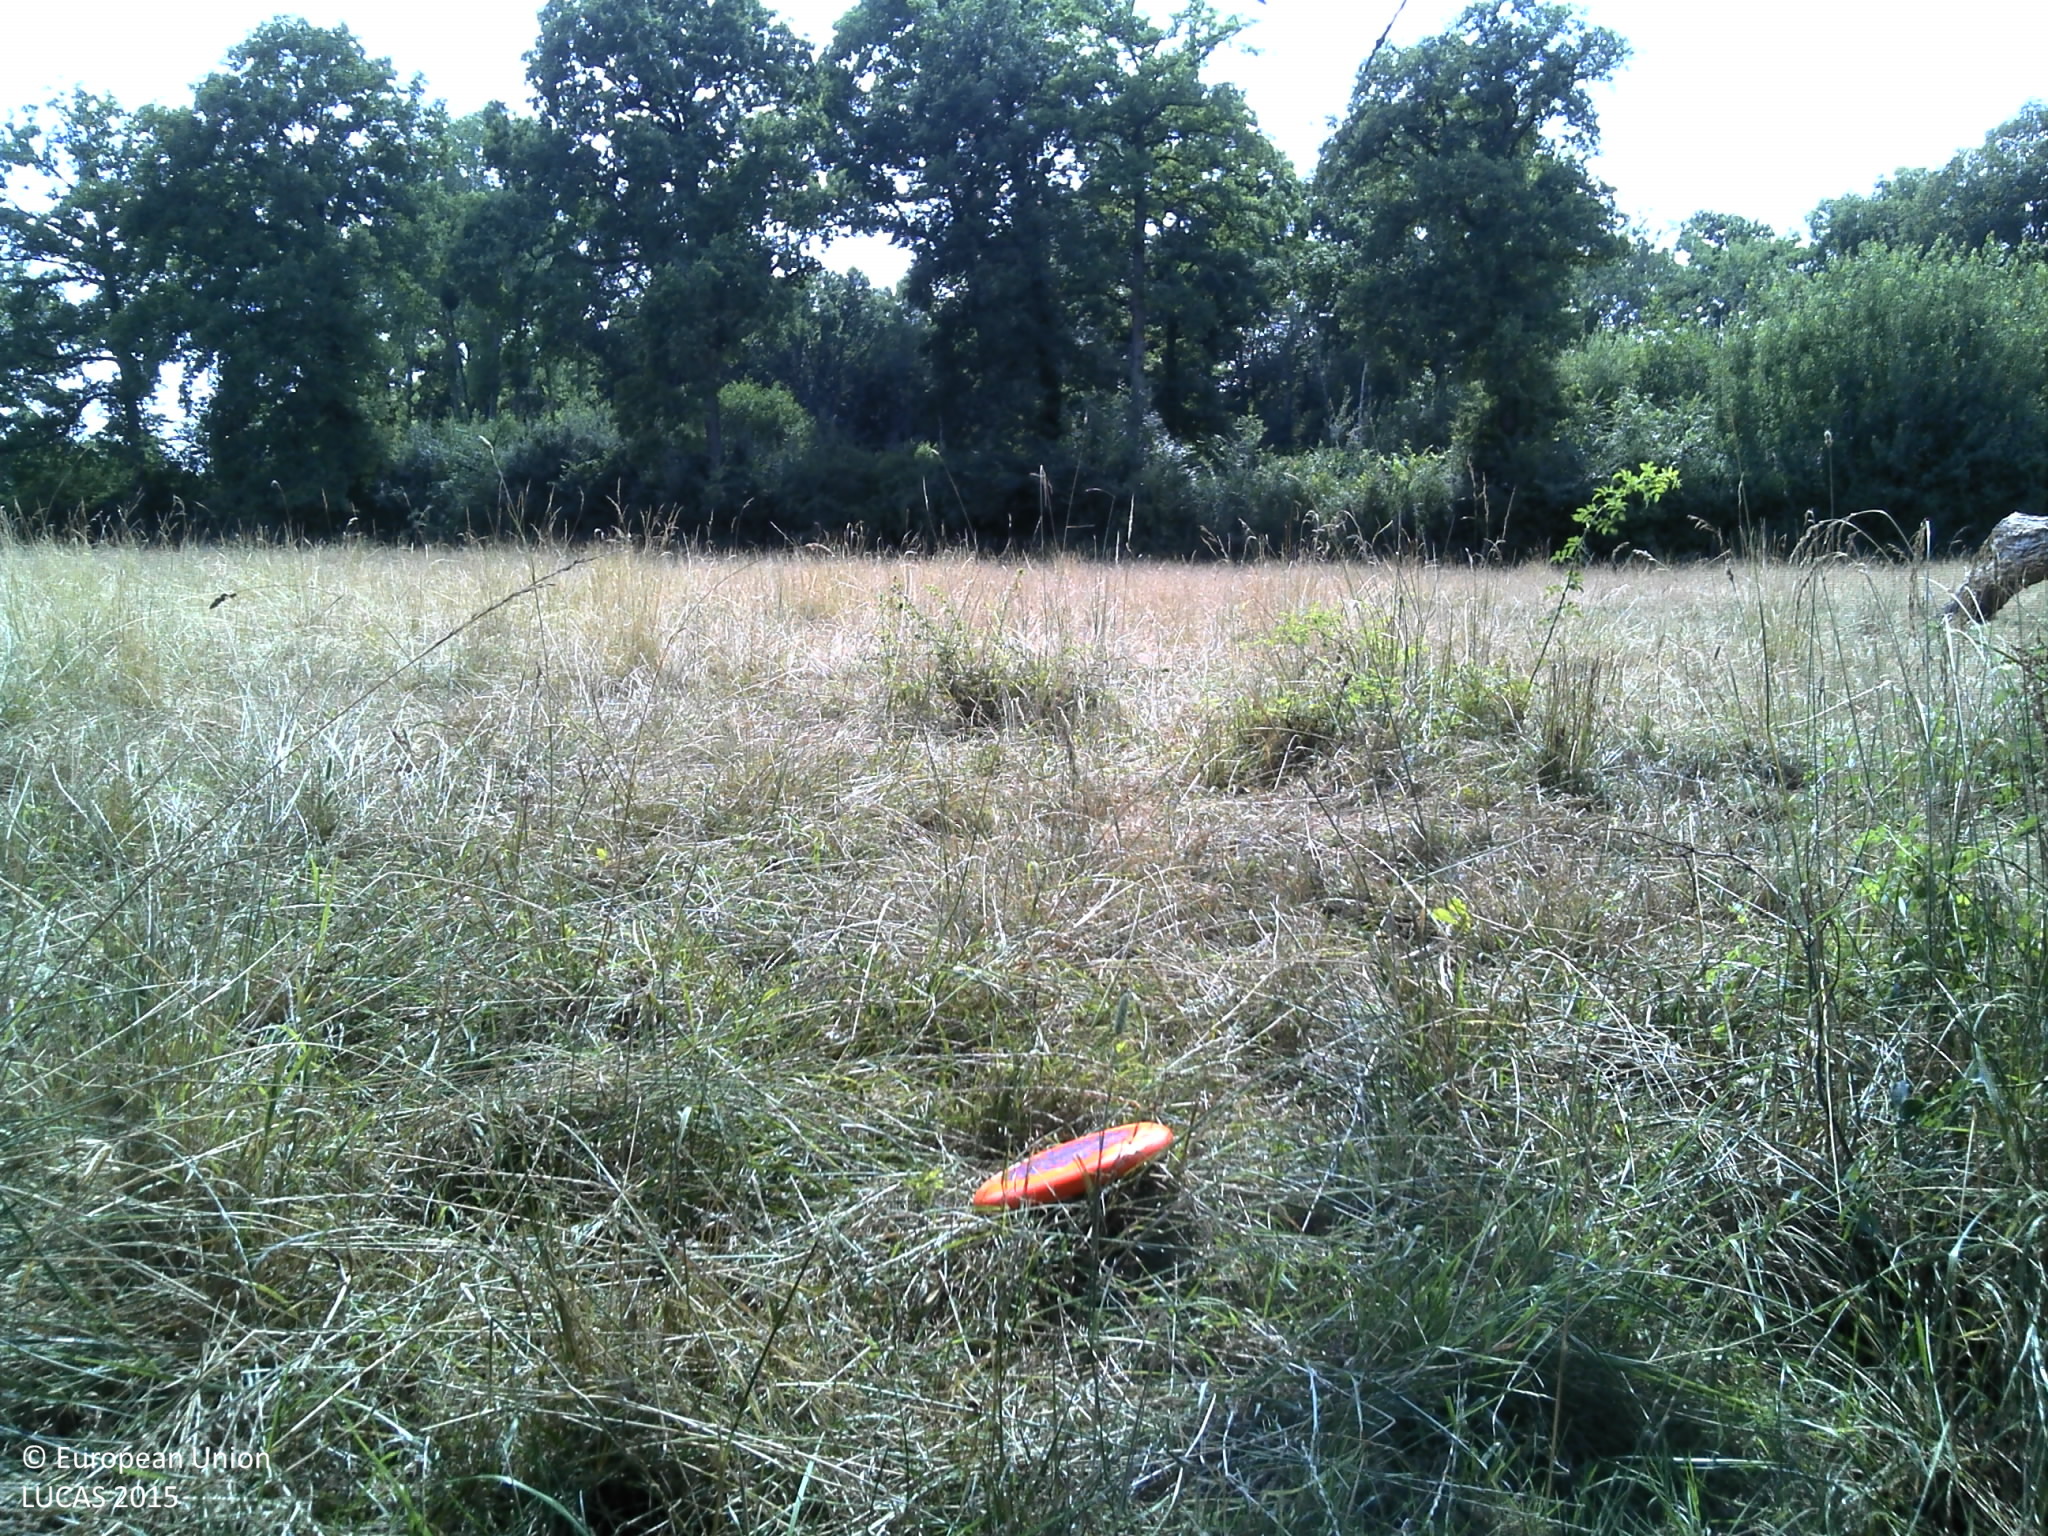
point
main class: Grassland
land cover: Grassland without tree/shrub cover
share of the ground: > 75 %
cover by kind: herbaceous plants 100 %
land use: Agriculture (excluding fallow land and kitchen gardens)
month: July
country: FR
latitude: 48.6764
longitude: 4.7690
